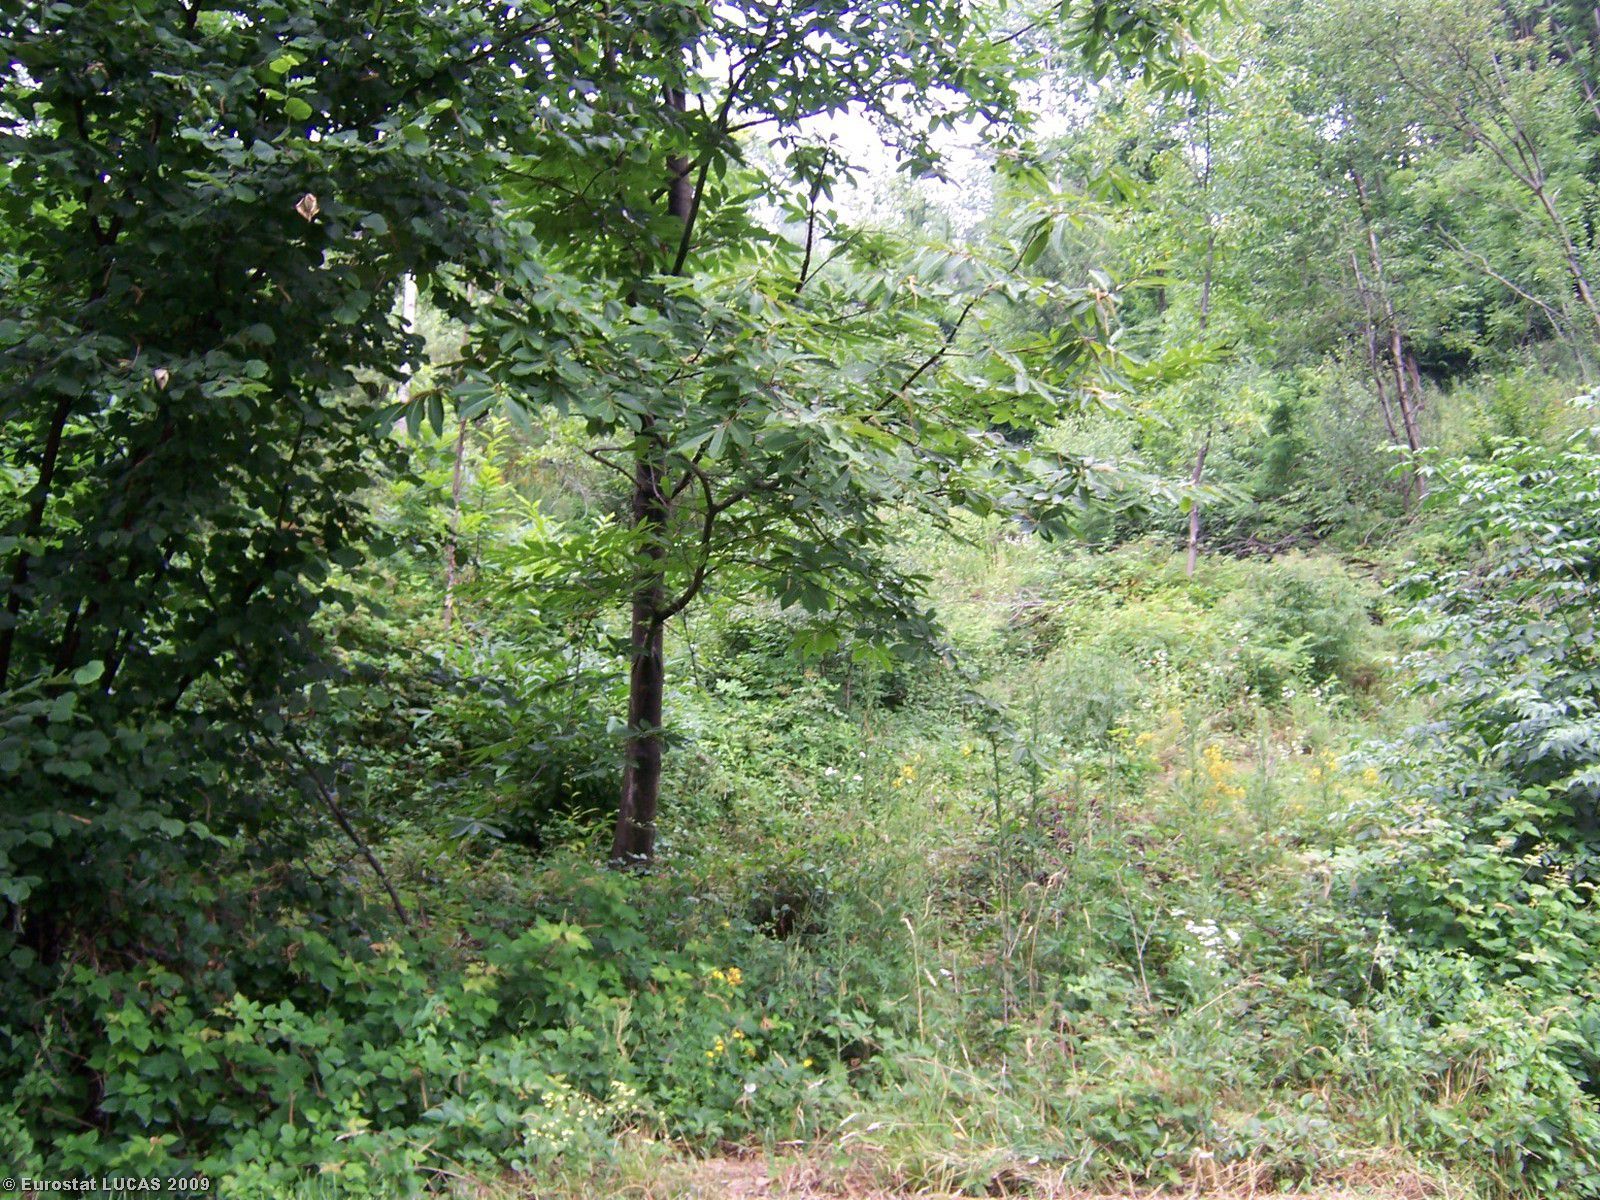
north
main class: Woodland
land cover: Broadleaved woodland
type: mesophytic deciduous forest
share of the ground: 50 - 75 %
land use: Unused
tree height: > 5 m
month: July
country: IT
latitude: 45.0197
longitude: 7.3270
